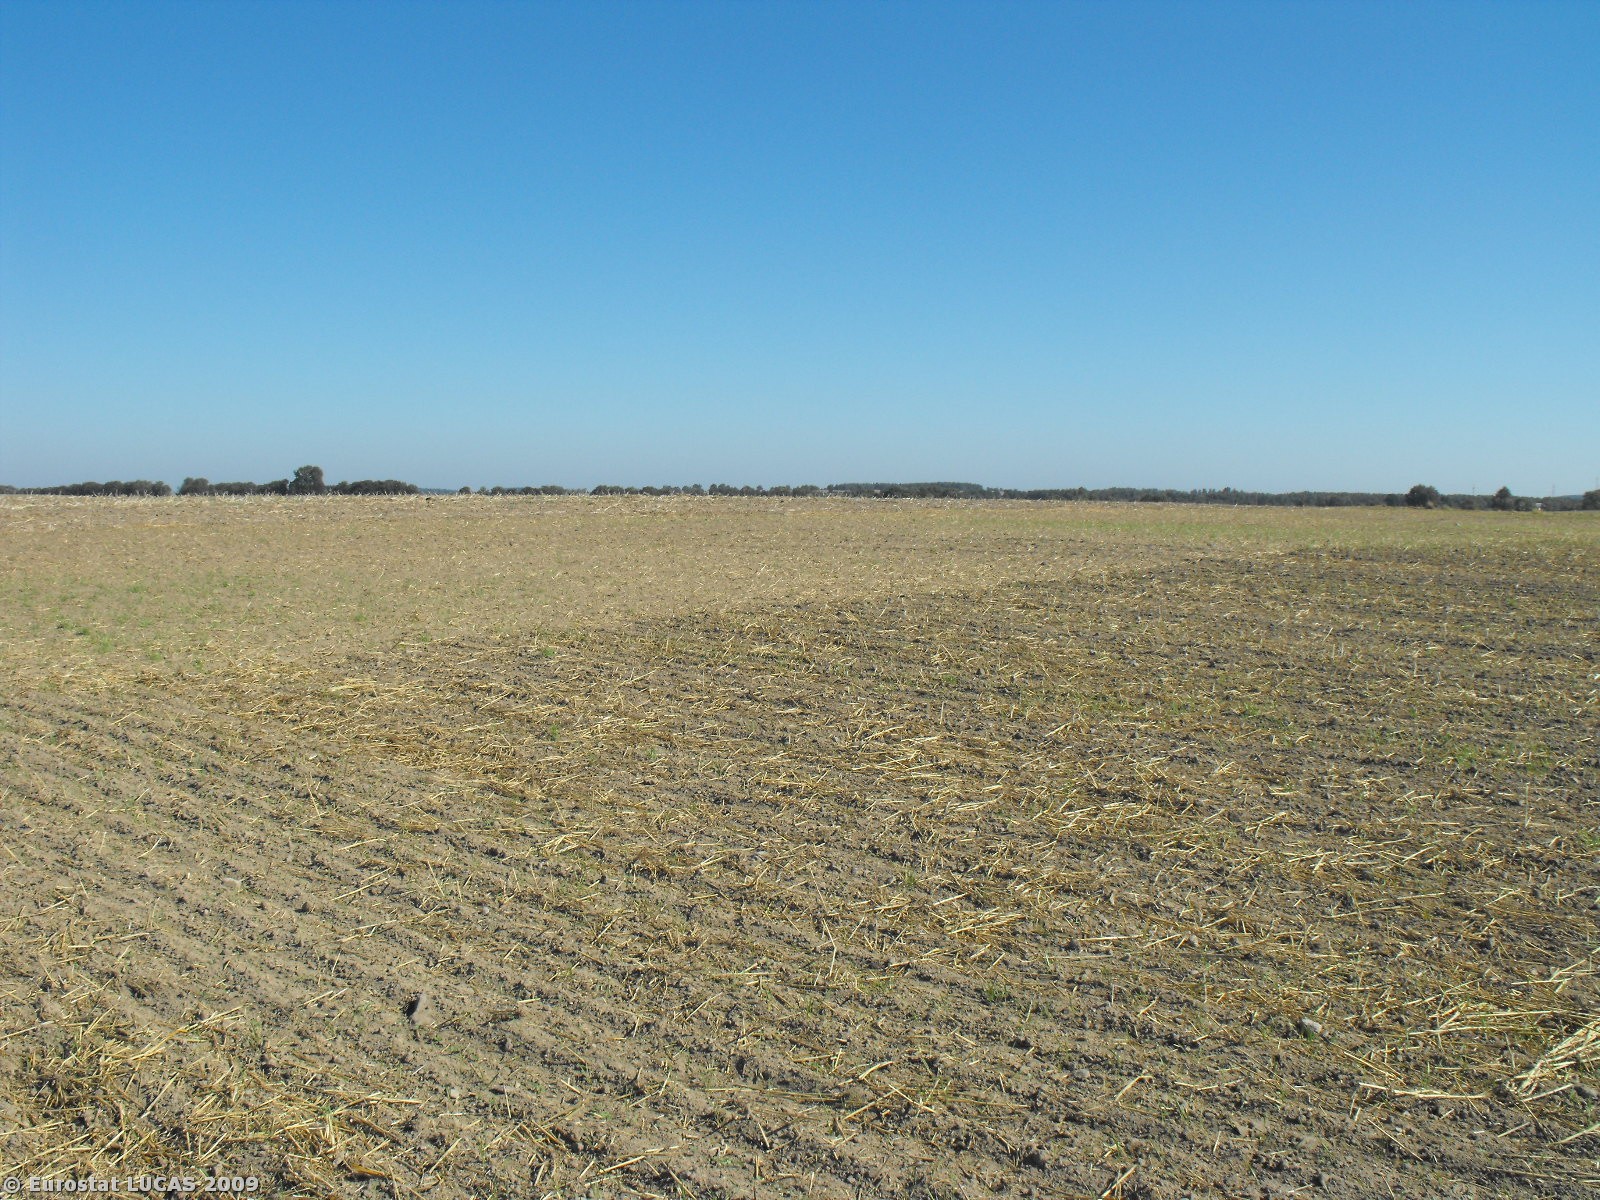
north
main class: Cropland
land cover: Triticale
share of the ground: < 10 %
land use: Agriculture (excluding fallow land and kitchen gardens)
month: September
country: PL
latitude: 53.2066
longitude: 16.5501
